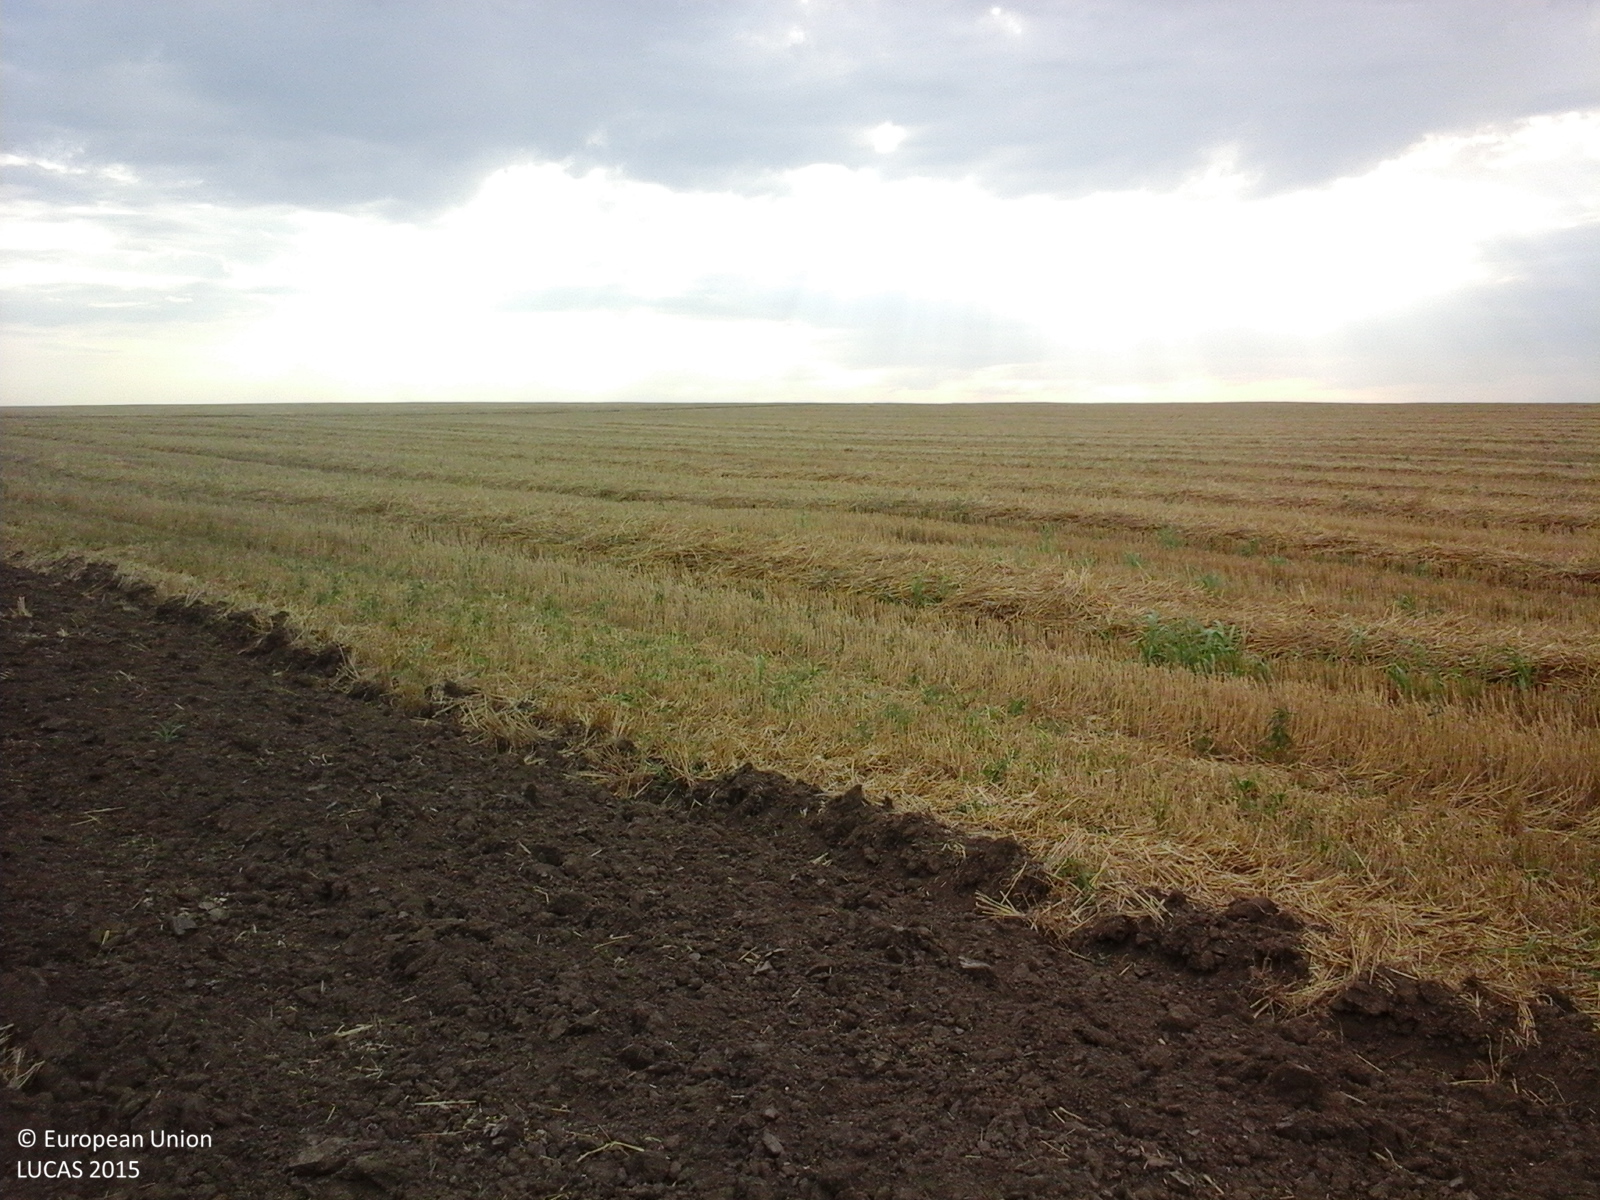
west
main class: Cropland
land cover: Maize
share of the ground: > 75 %
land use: Agriculture (excluding fallow land and kitchen gardens)
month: August
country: RO
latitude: 44.2150
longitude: 28.3256
